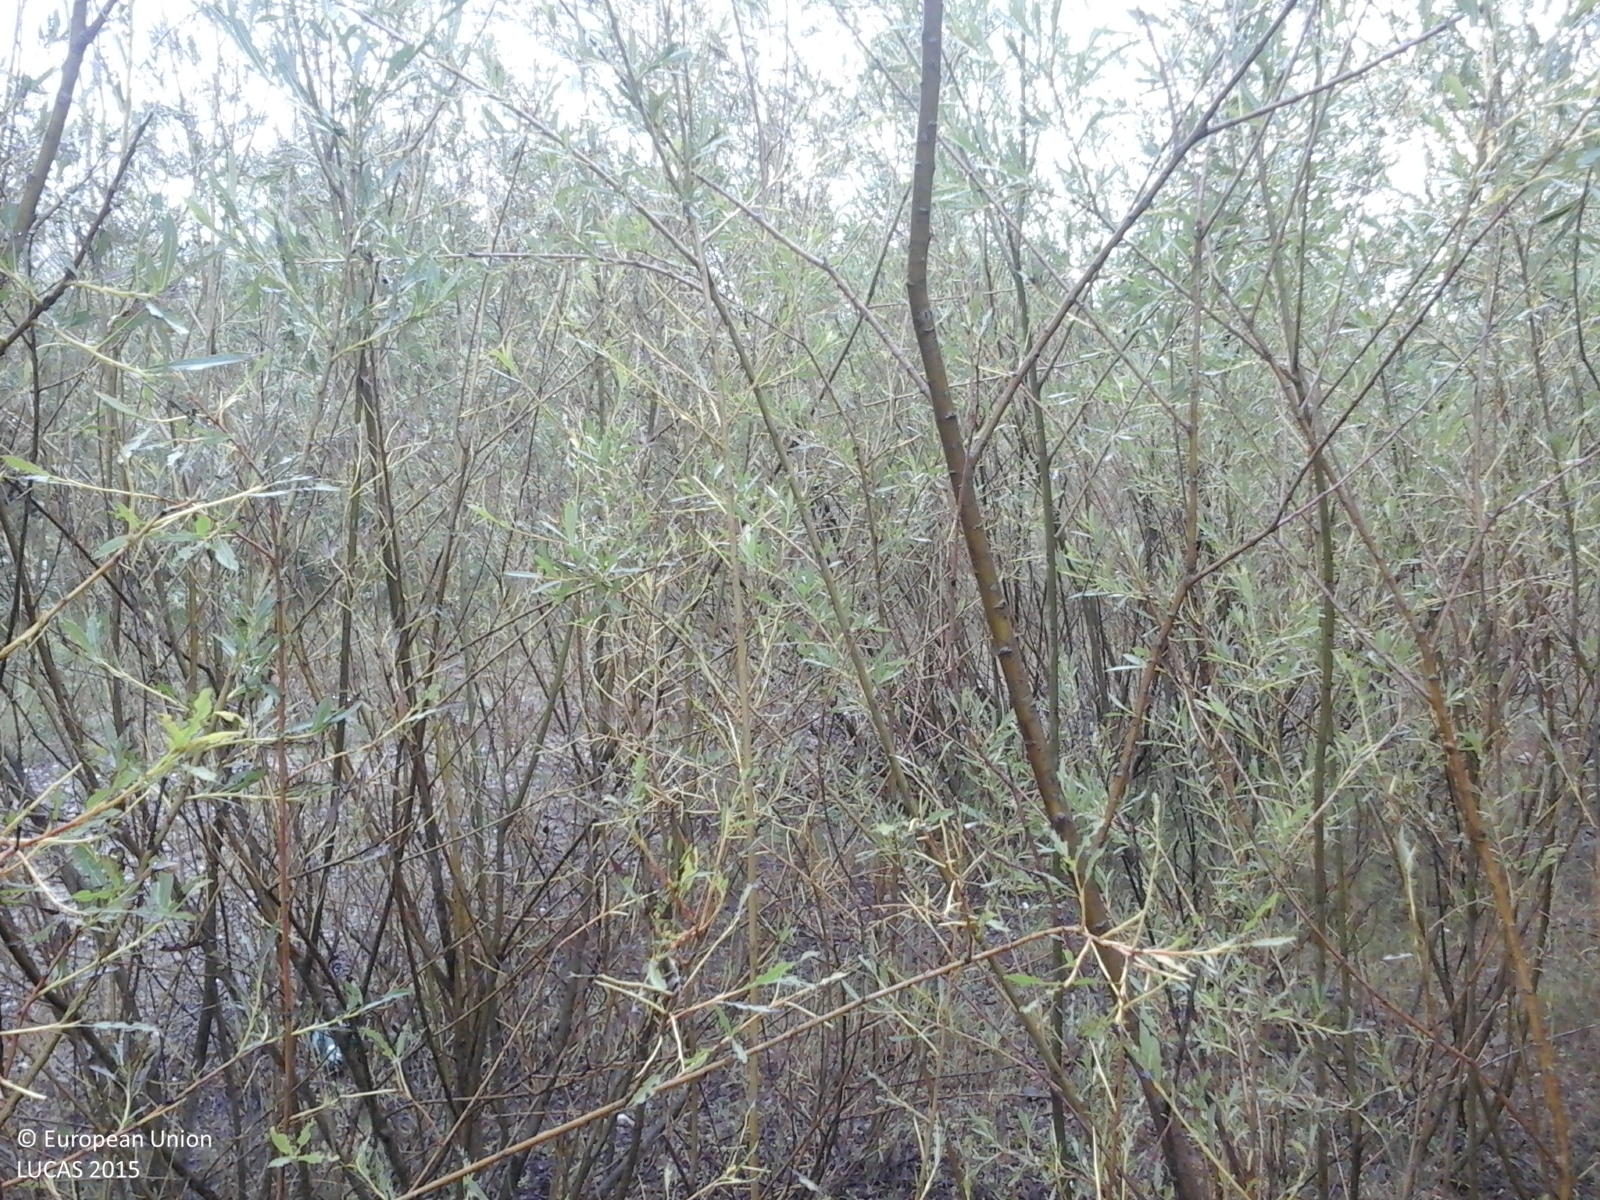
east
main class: Shrubland
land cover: Shrubland without tree cover
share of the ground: 50 - 75 %
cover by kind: shrubs 75 %, herbaceous plants 25 %
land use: Semi-natural and natural areas not in use
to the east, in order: Shrubland without tree cover; Grassland with sparse tree/shrub cover; Shrubland with sparse tree cover; Tracks; Grassland without tree/shrub cover
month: June
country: RO
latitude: 47.3542
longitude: 26.3815
